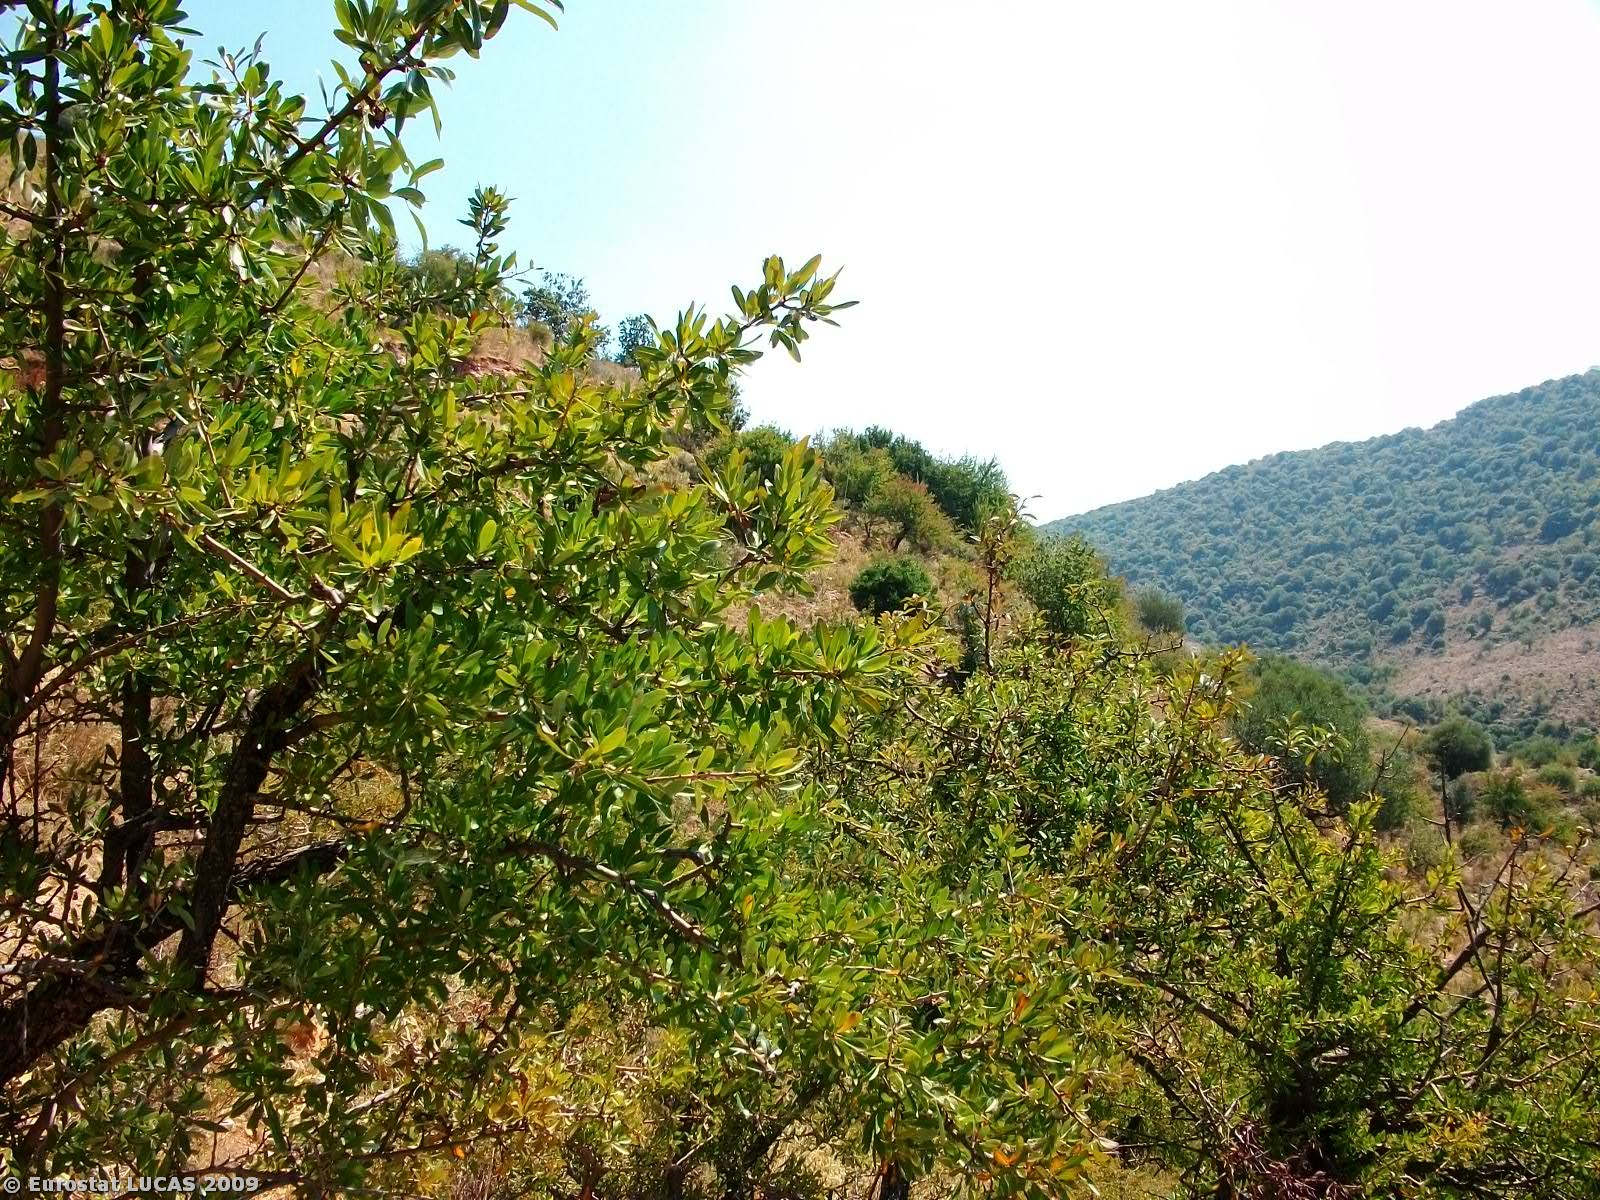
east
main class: Grassland
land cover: Grassland with sparse tree/shrub cover
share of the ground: 50 - 75 %
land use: Agriculture (excluding fallow land and kitchen gardens)
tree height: < 5 m
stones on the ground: 25 - 50 %
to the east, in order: Grassland with sparse tree/shrub cover; Grass margins; Paved roads, cycling and walking lanes; Grass margins; Grassland with sparse tree/shrub cover
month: September
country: GR
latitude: 39.5061
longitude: 20.2898
